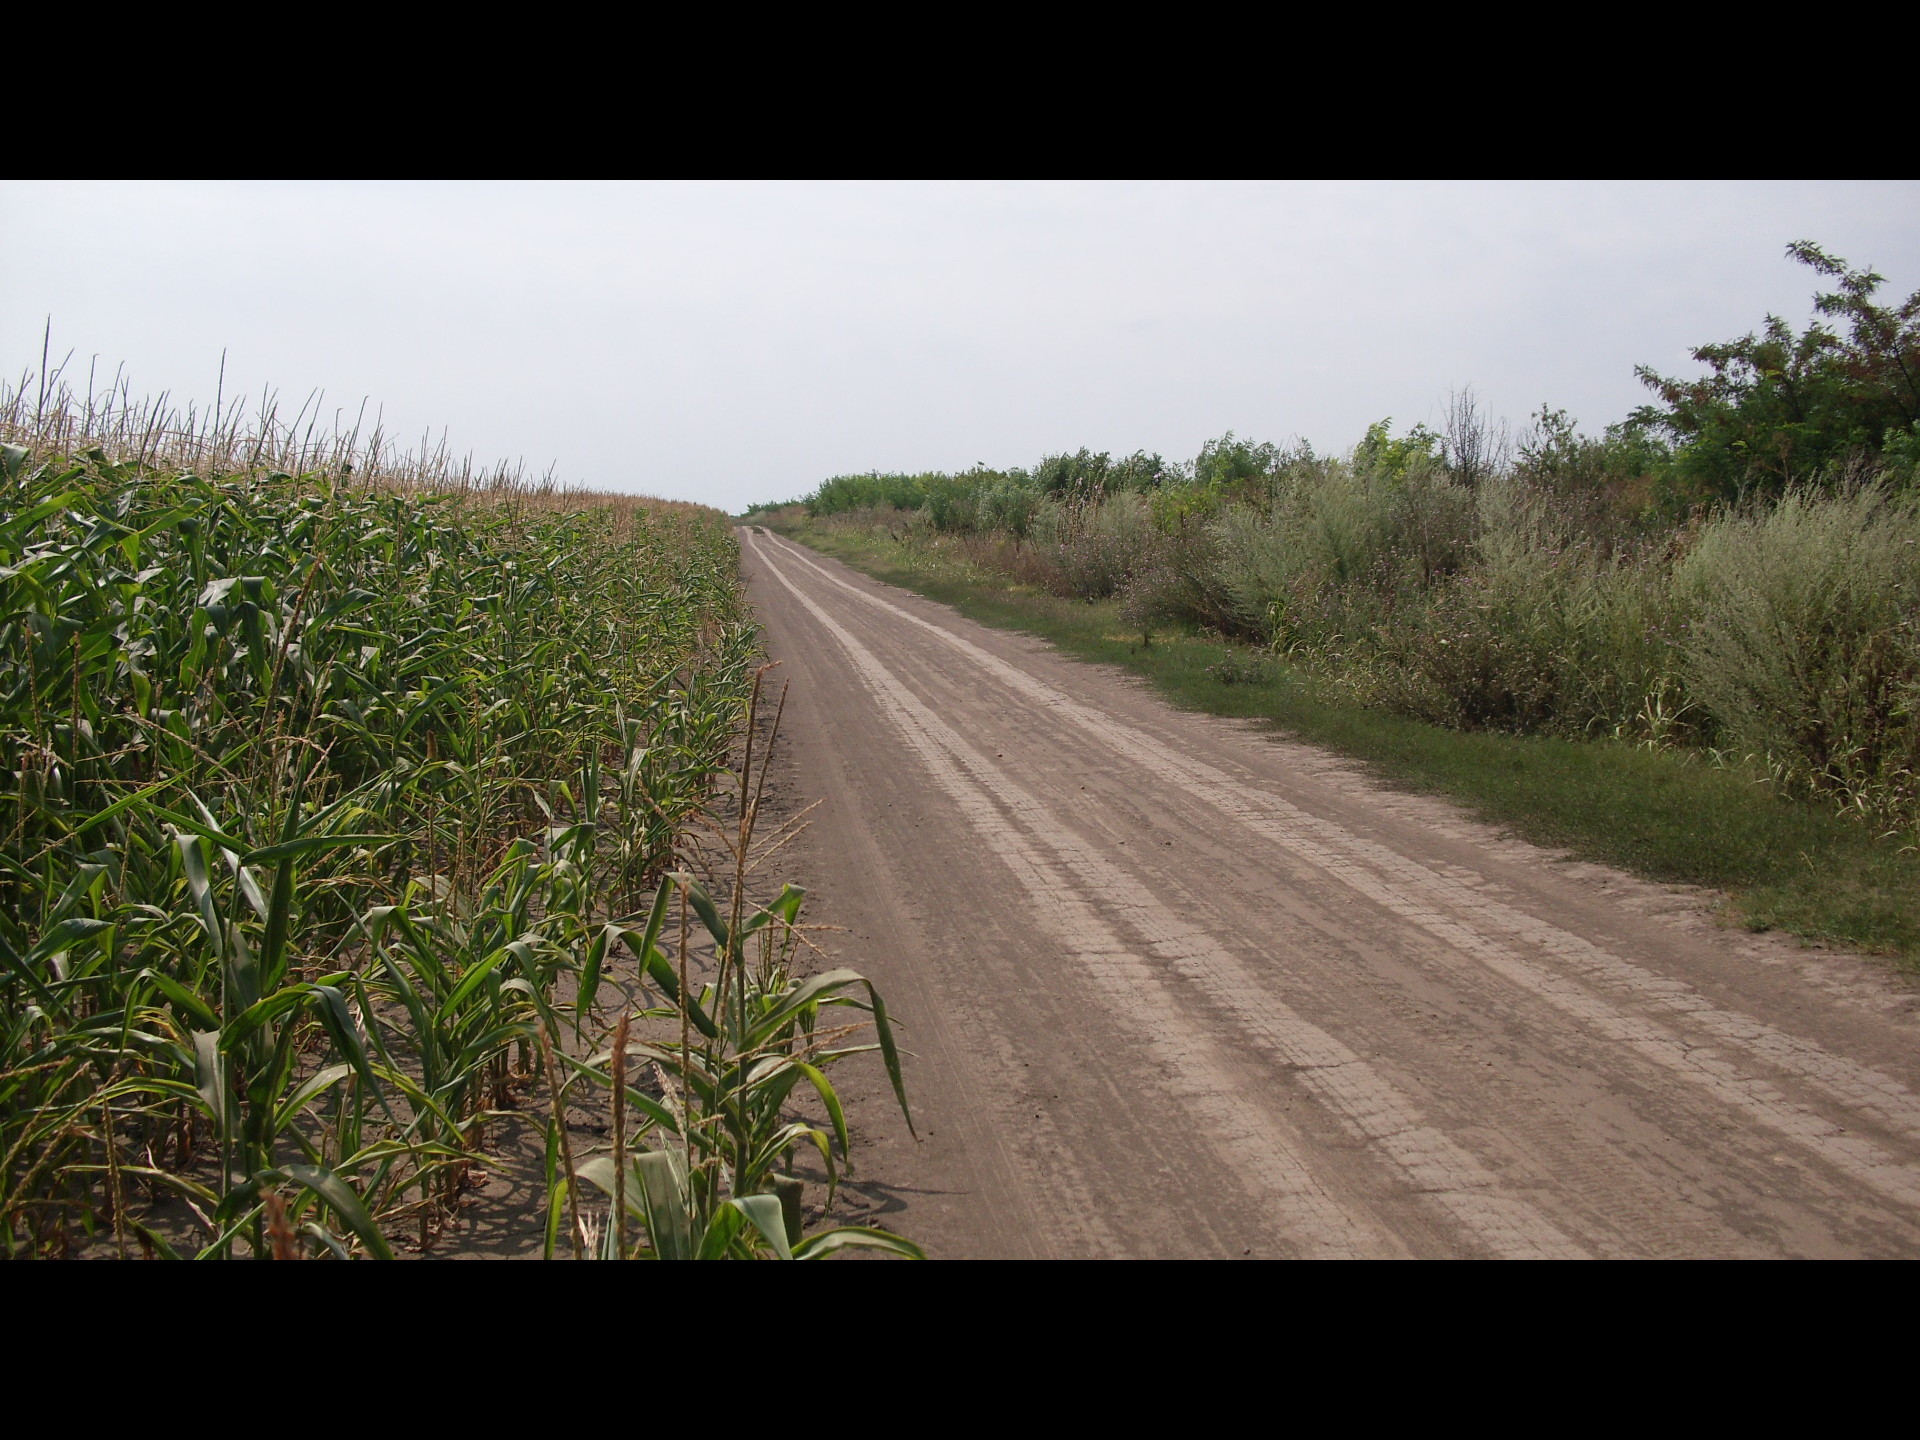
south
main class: Cropland
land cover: Maize
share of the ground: > 75 %
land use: Agriculture (excluding fallow land and kitchen gardens)
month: August
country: BG
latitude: 43.7014
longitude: 23.6363
